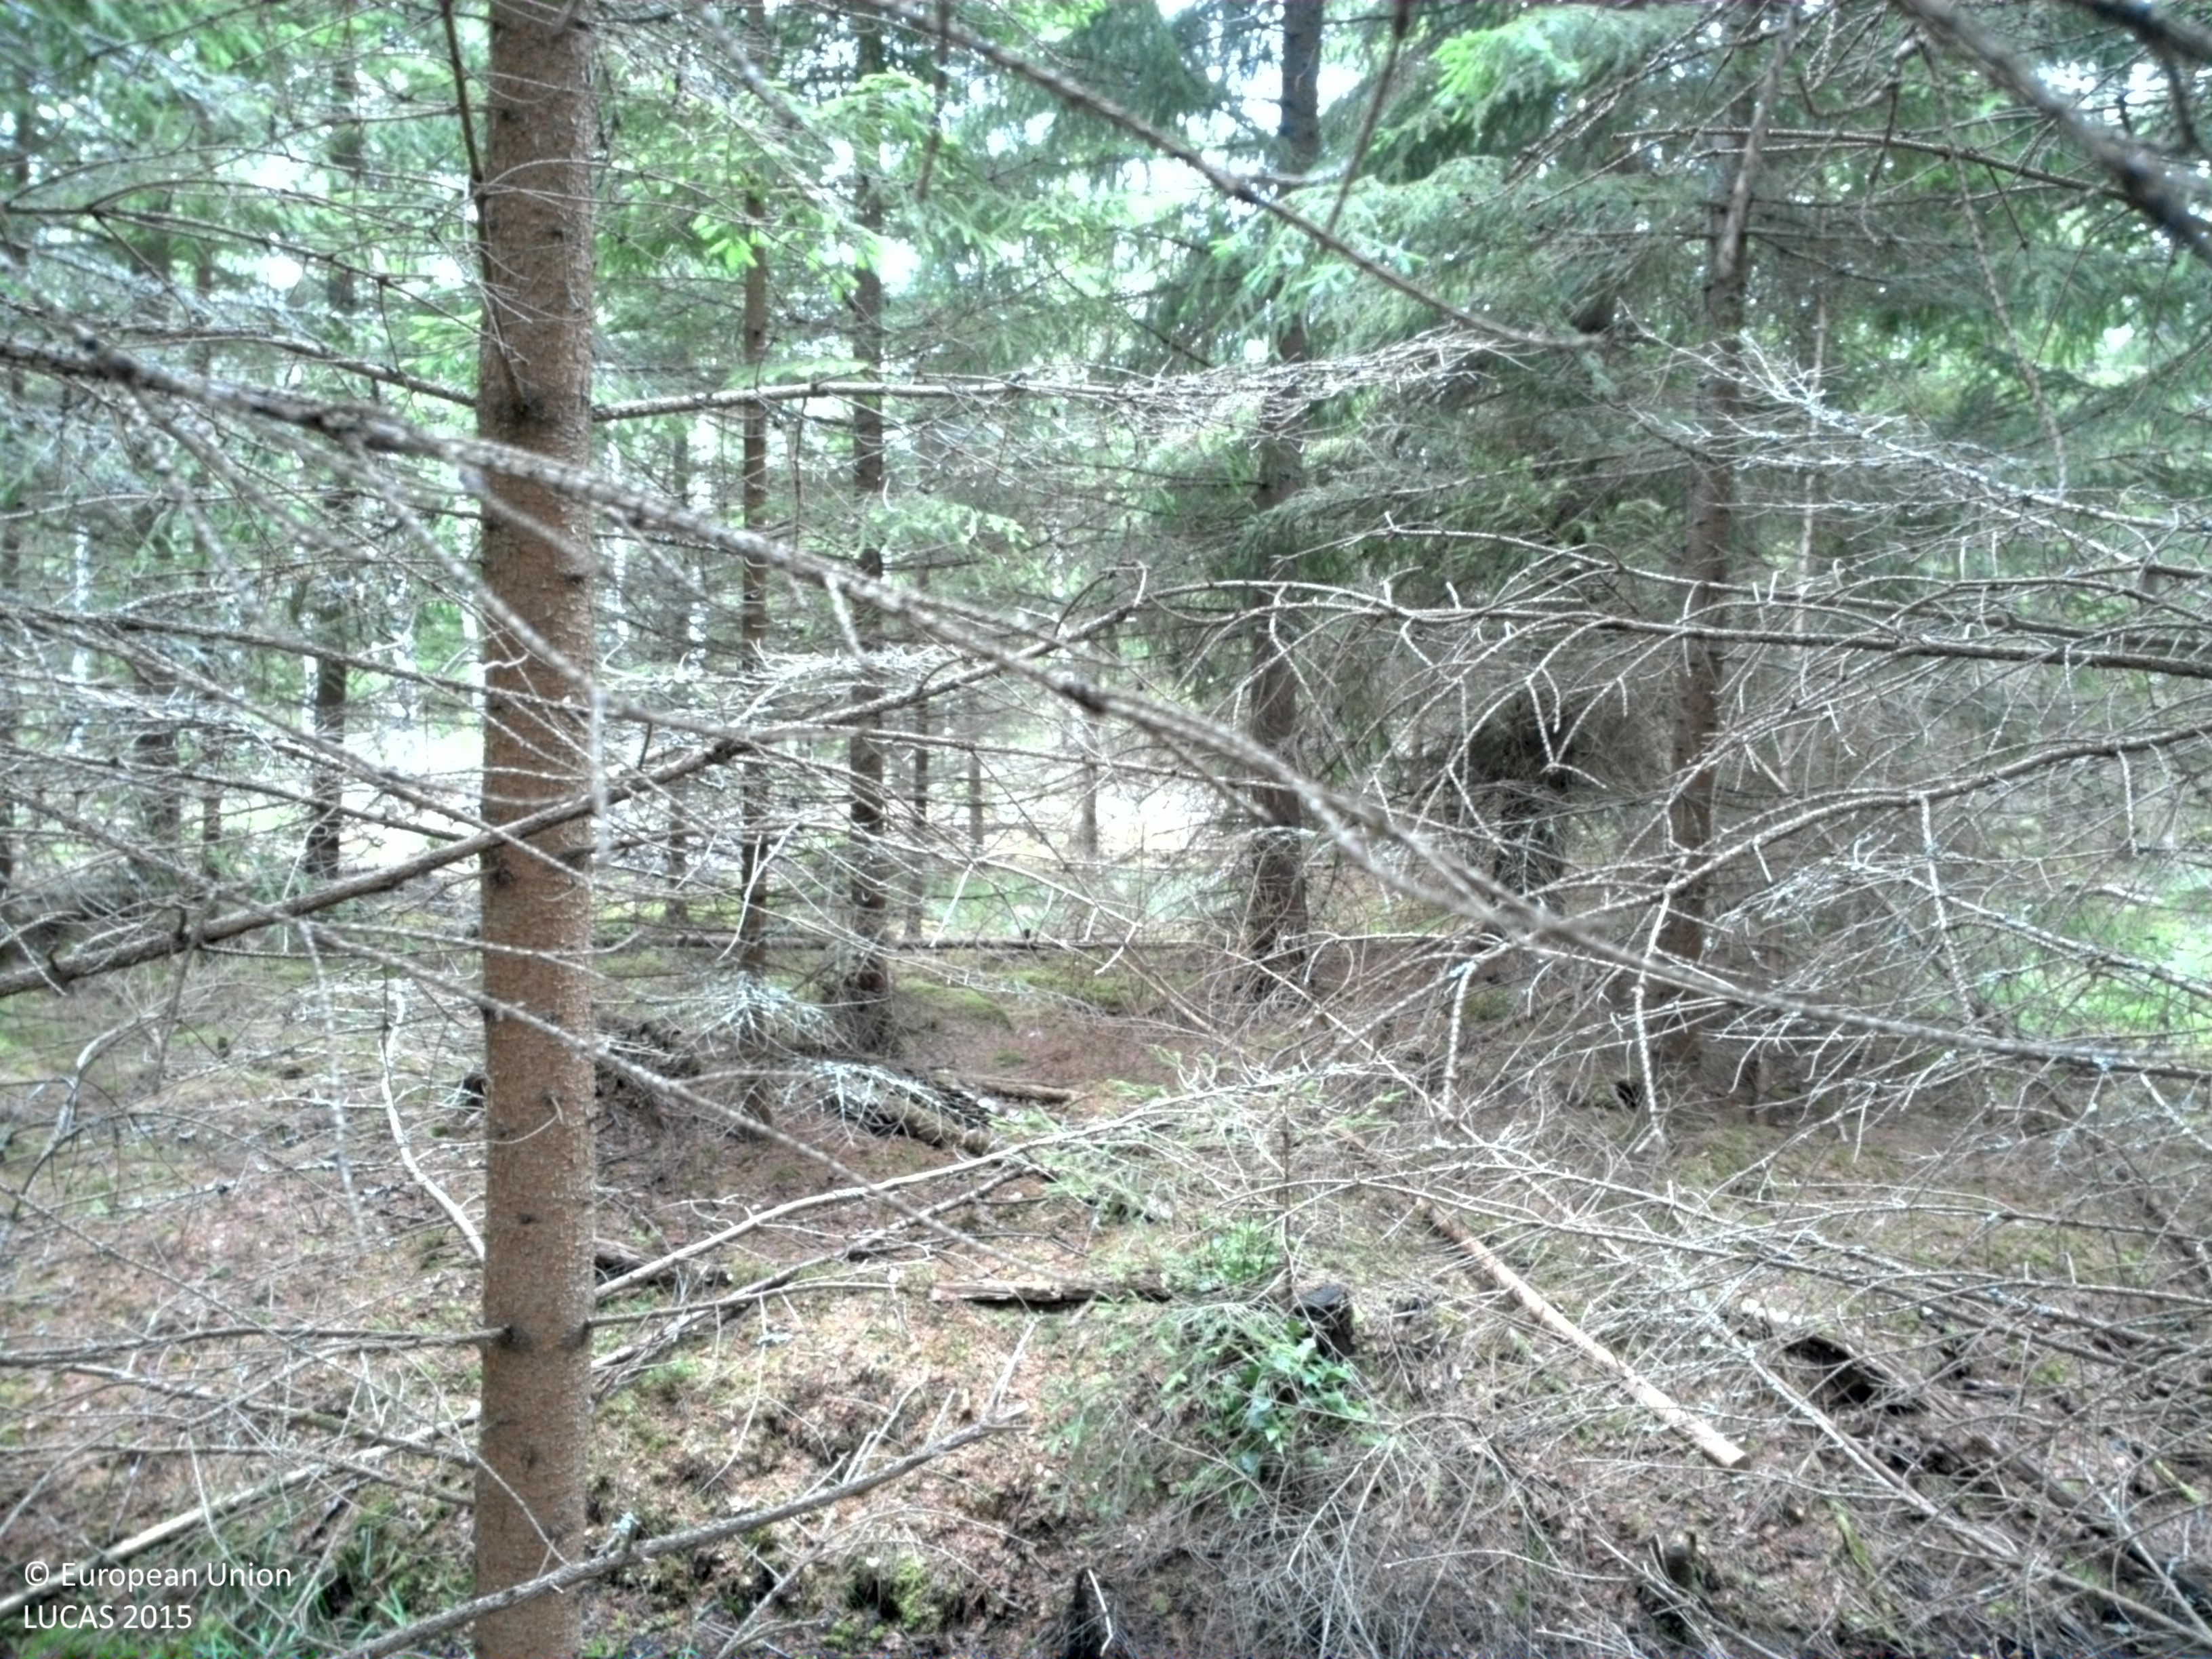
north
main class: Woodland
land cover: Spruce dominated coniferous woodland
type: boreal forest
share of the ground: > 75 %
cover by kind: coniferous forest trees 85 %, unconsolidated bare surface 10 %, lichens and mosses 5 %
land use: Forestry
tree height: > 5 m
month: July
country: SE
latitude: 58.3592
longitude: 13.2928
